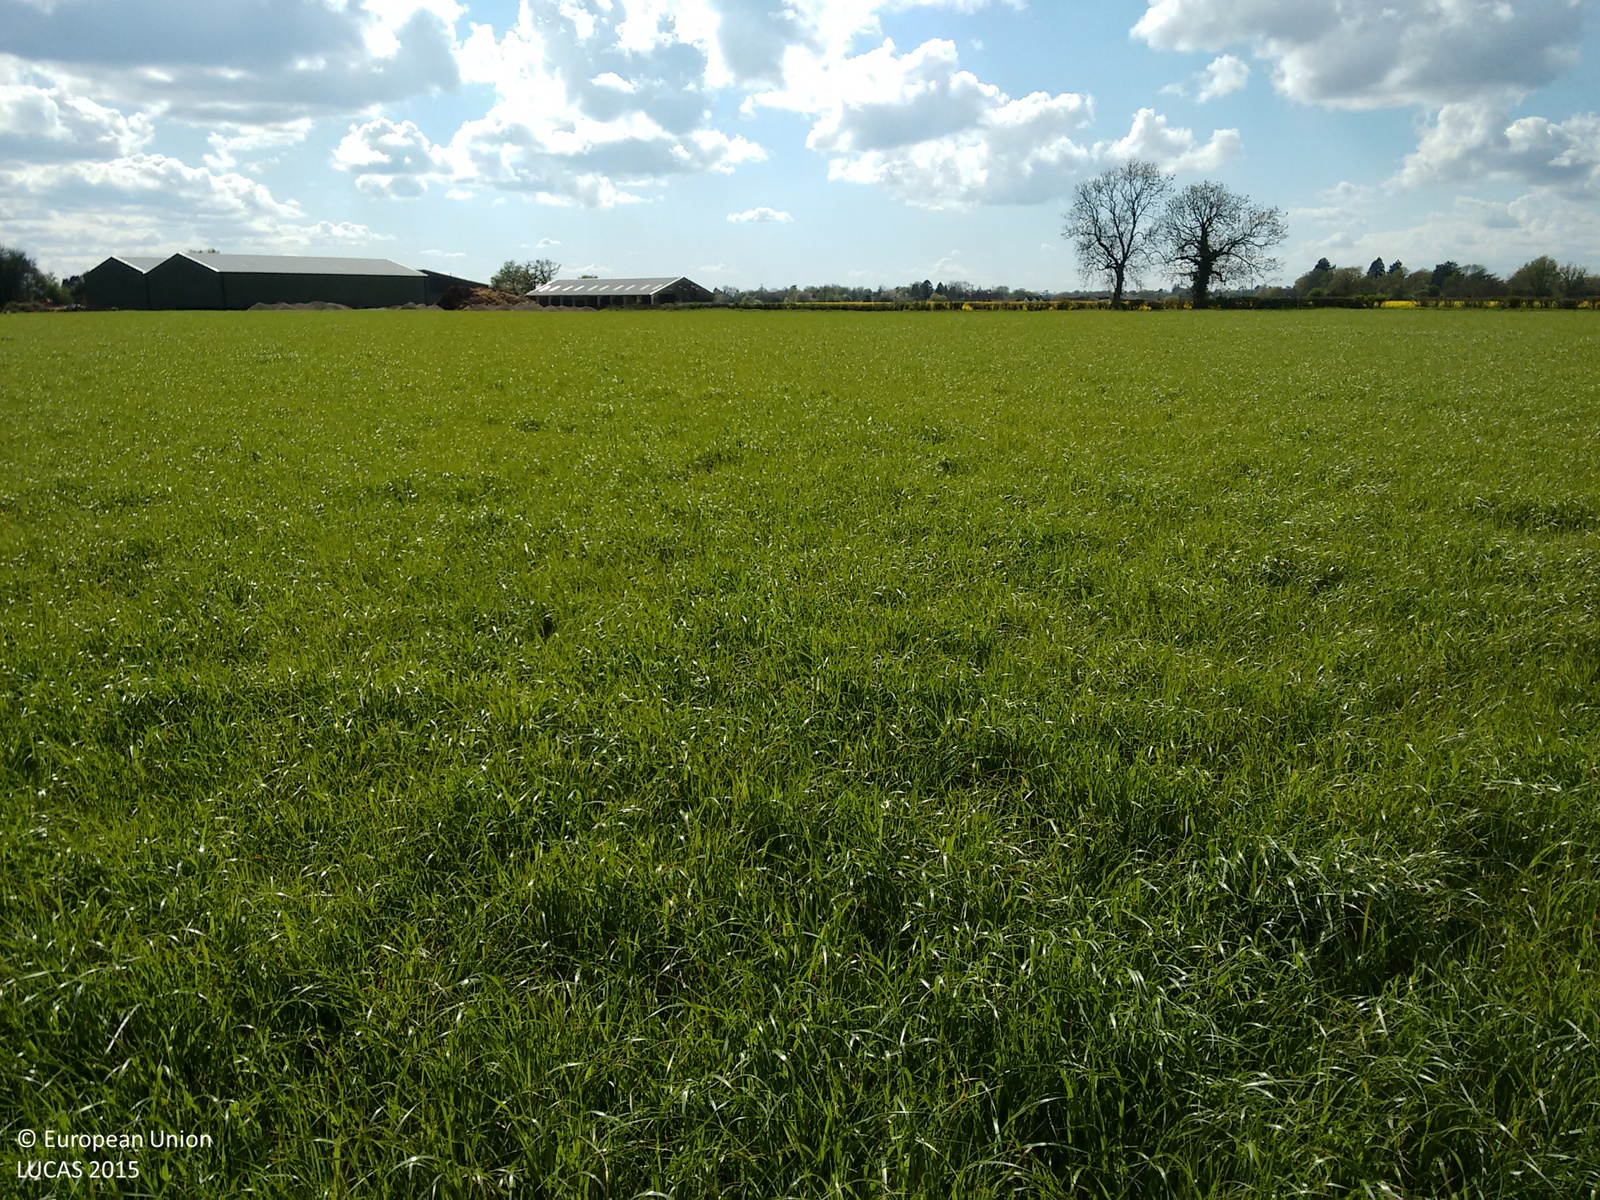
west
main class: Cropland
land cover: Common wheat
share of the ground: > 75 %
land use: Agriculture (excluding fallow land and kitchen gardens)
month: April
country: GB
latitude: 51.7234
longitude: -0.5636
